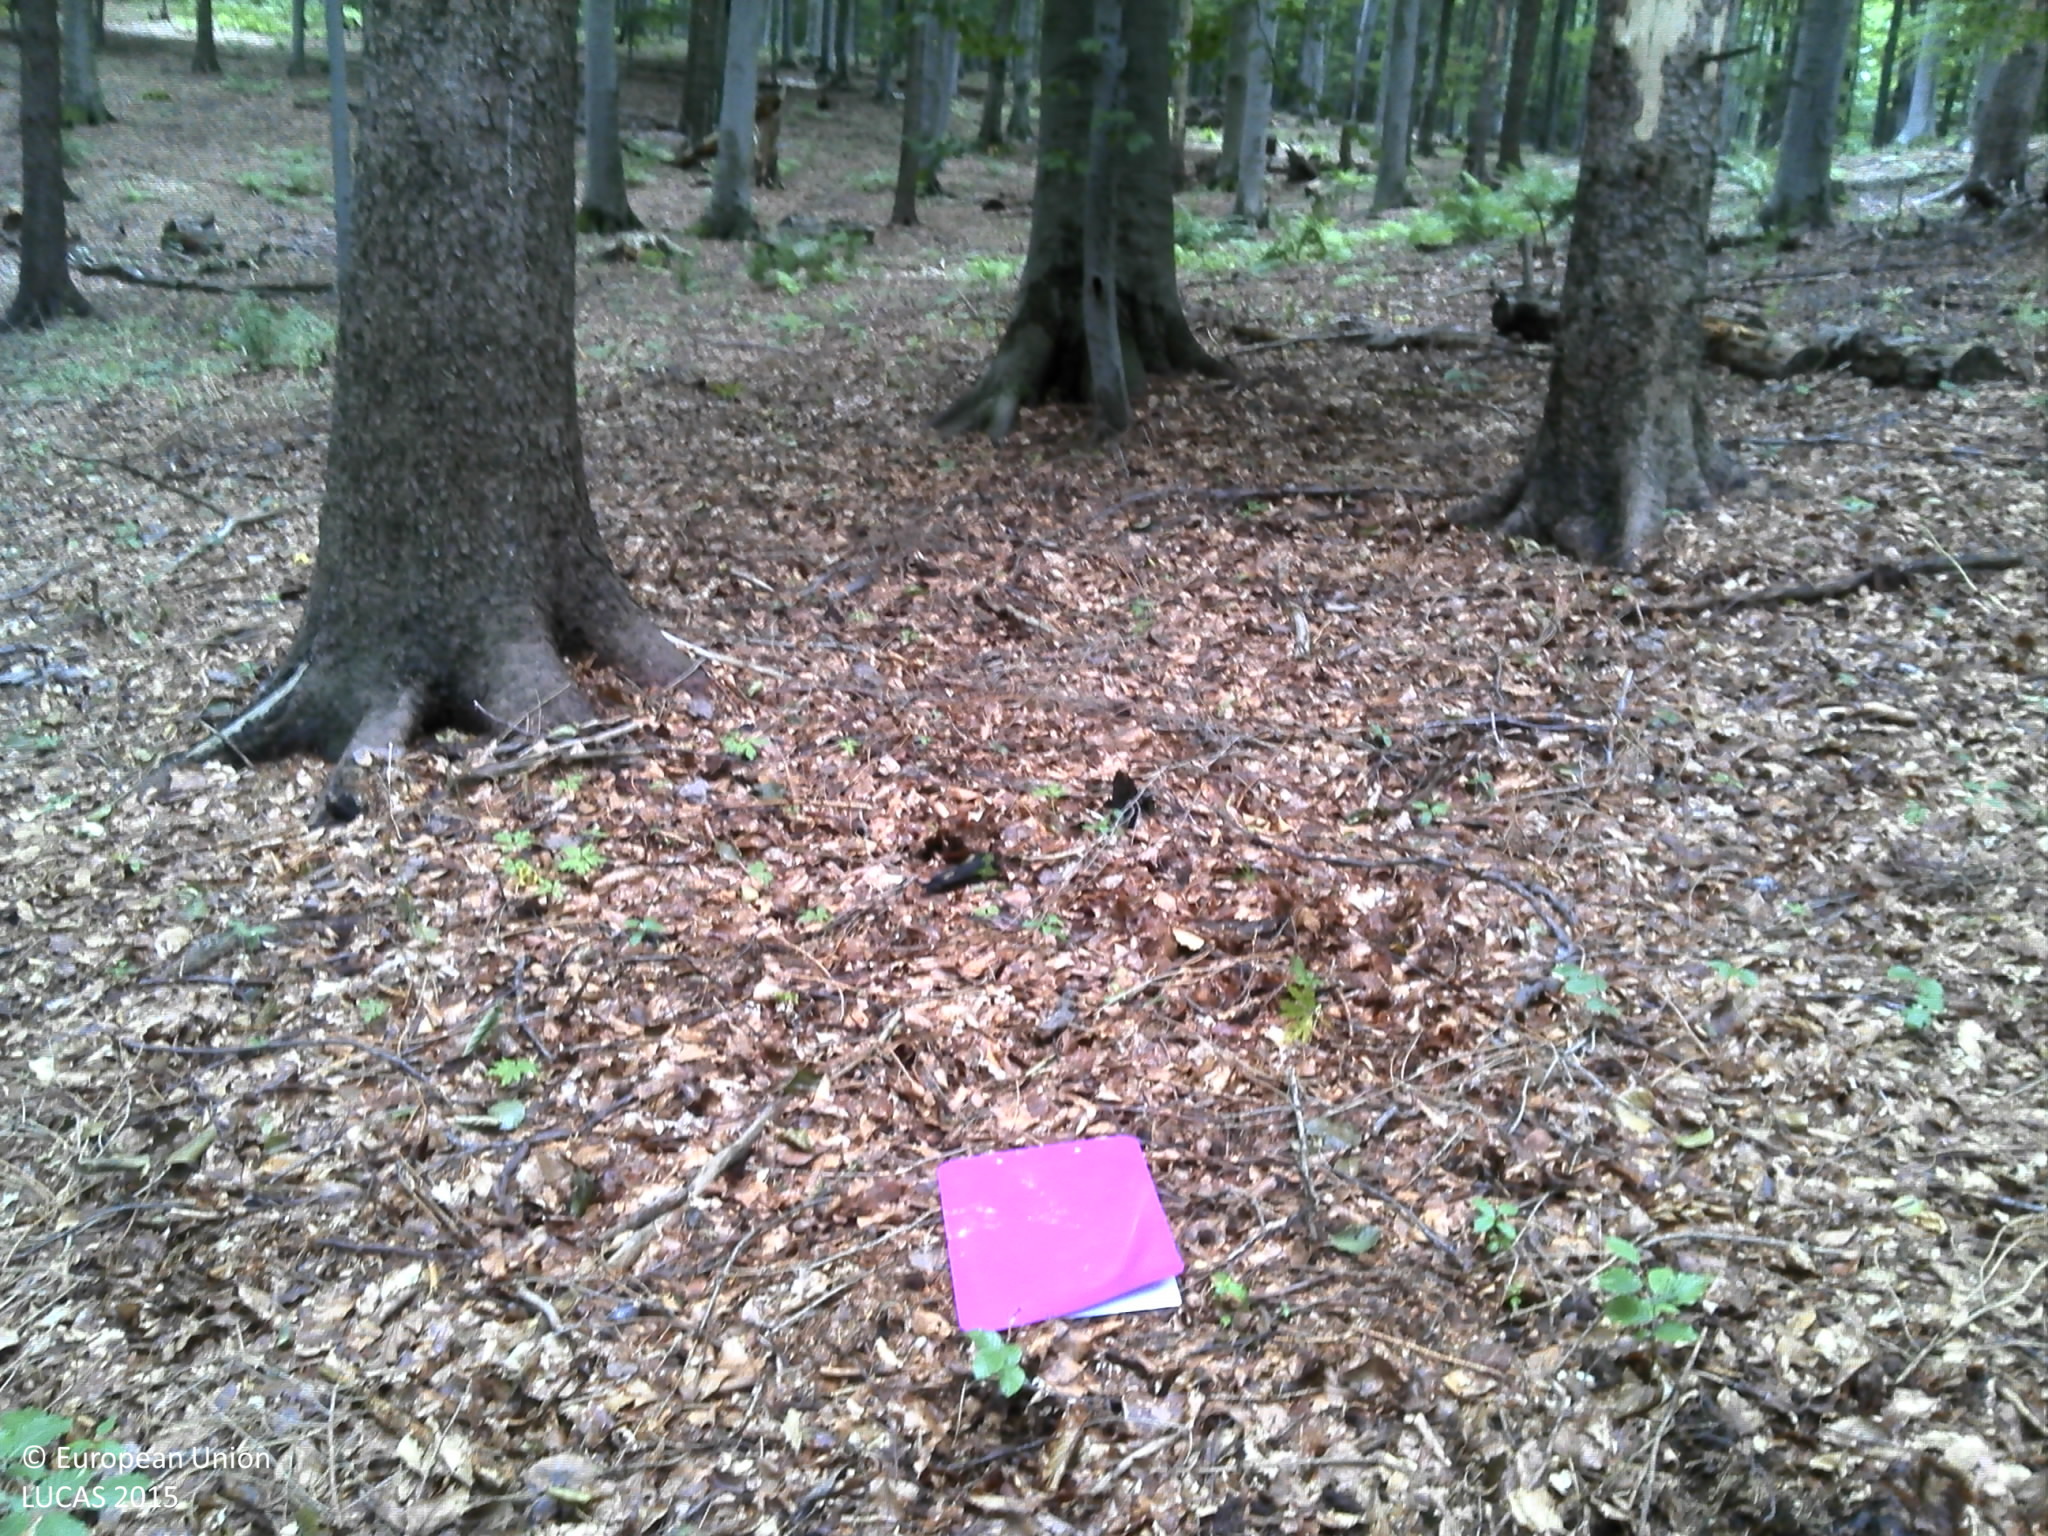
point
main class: Woodland
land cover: Other mixed woodland
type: beech forest
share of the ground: > 75 %
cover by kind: broadleaved forest trees 60 %, coniferous forest trees 40 %
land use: Forestry
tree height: > 5 m
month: June
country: HR
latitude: 45.5132
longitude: 17.4385
